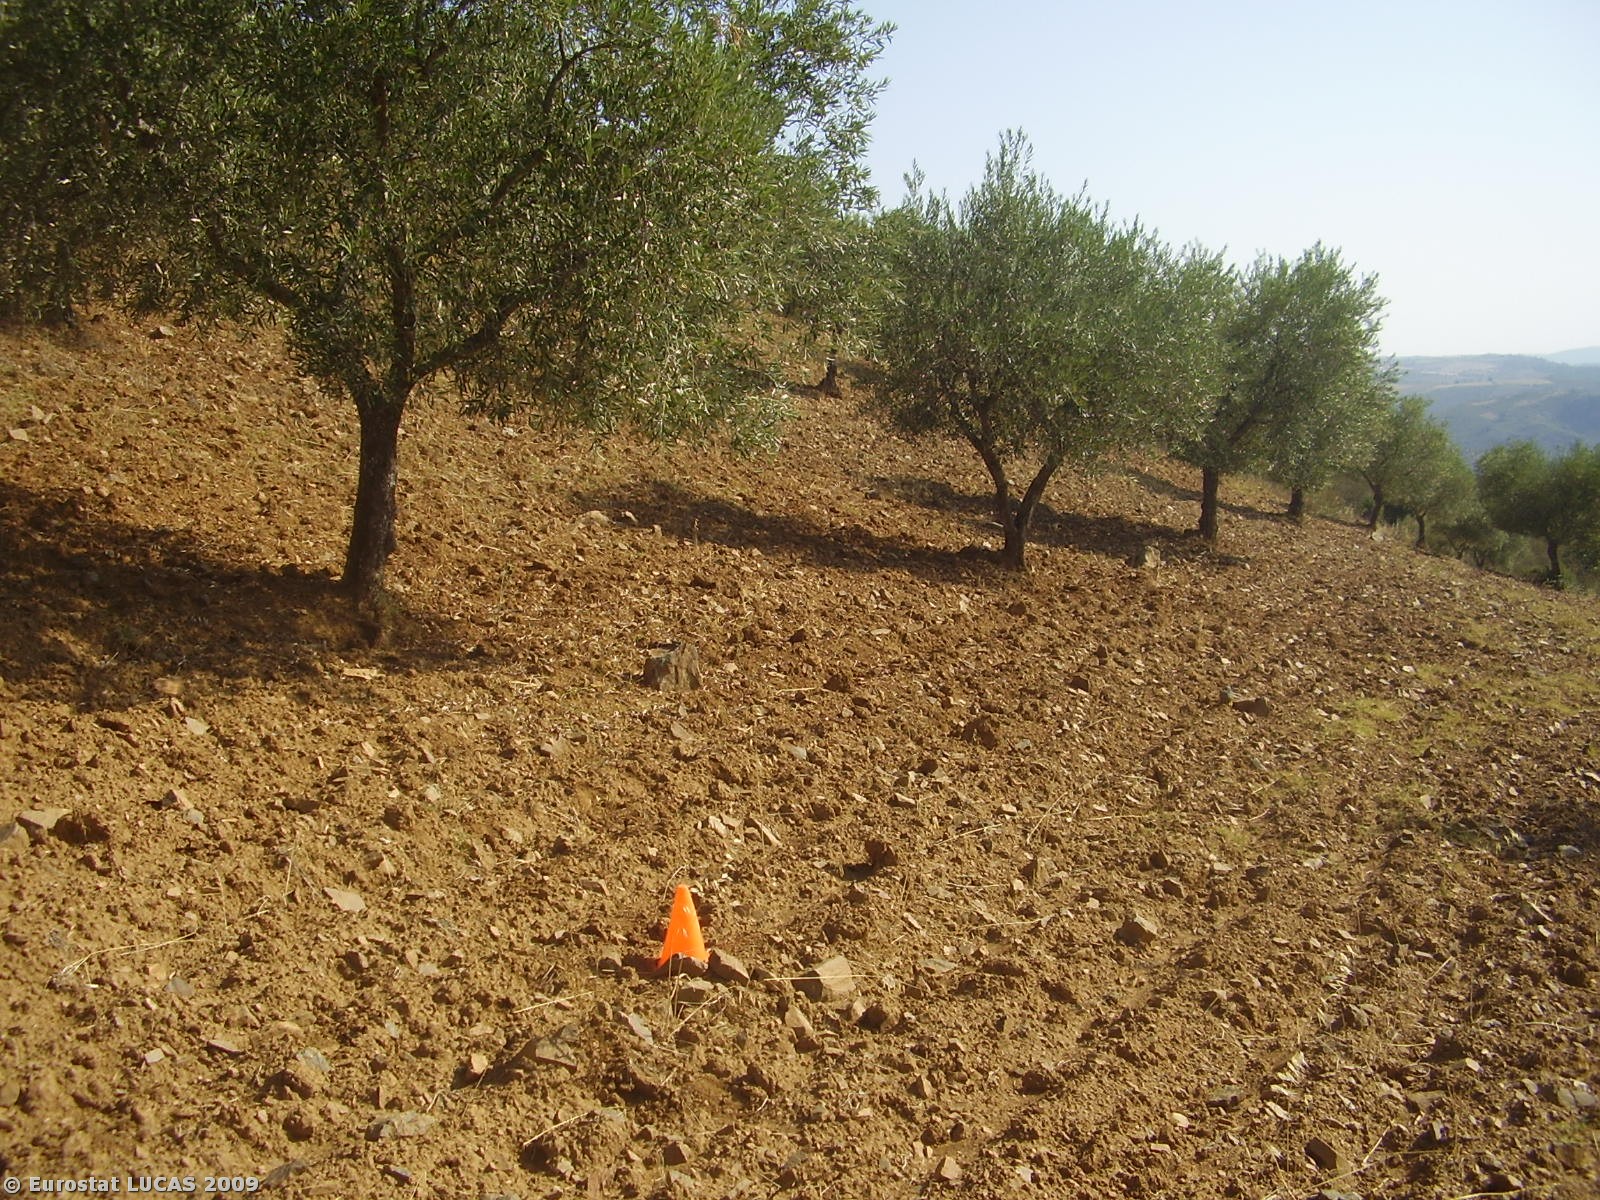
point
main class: Cropland
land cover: Olive groves
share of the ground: 10 - 25 %
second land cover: Bare land
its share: > 75 %
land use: Agriculture (excluding fallow land and kitchen gardens)
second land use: Fallow land
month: August
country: PT
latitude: 41.4014
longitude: -6.8187
